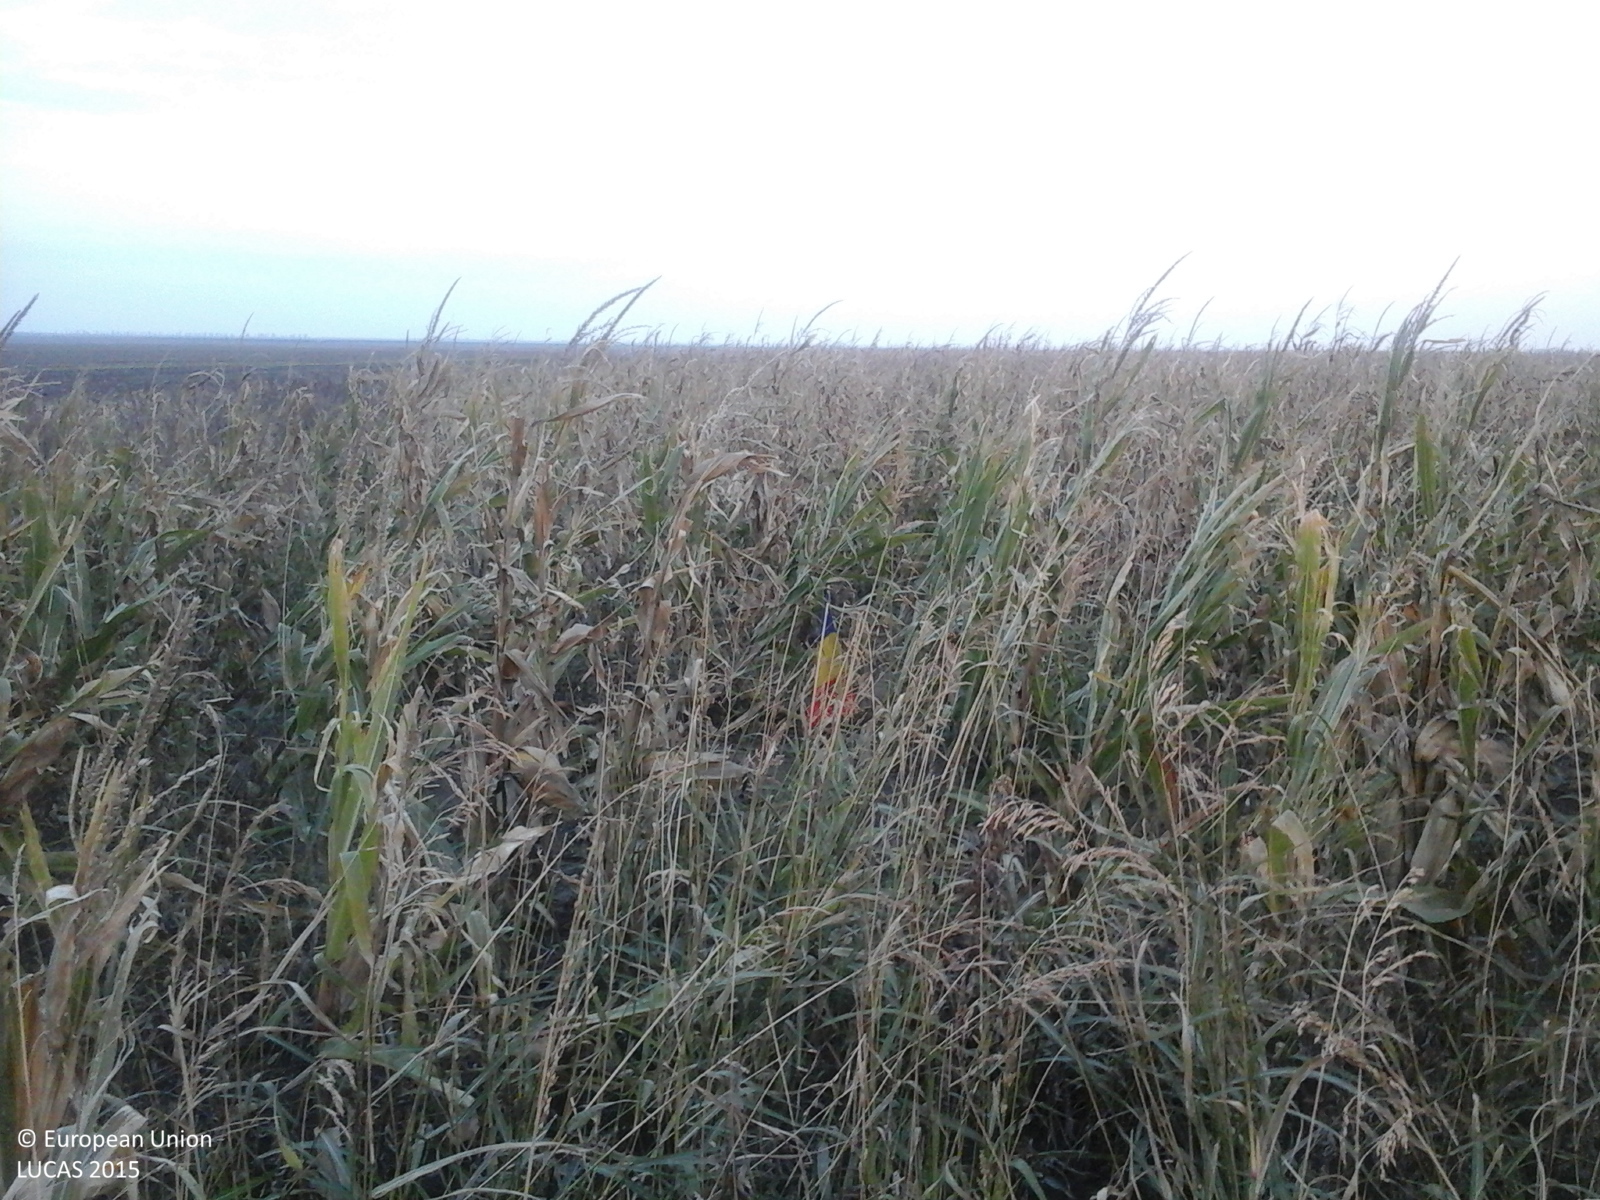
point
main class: Cropland
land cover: Maize
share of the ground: > 75 %
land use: Agriculture (excluding fallow land and kitchen gardens)
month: October
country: RO
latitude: 45.2542
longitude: 26.9947
